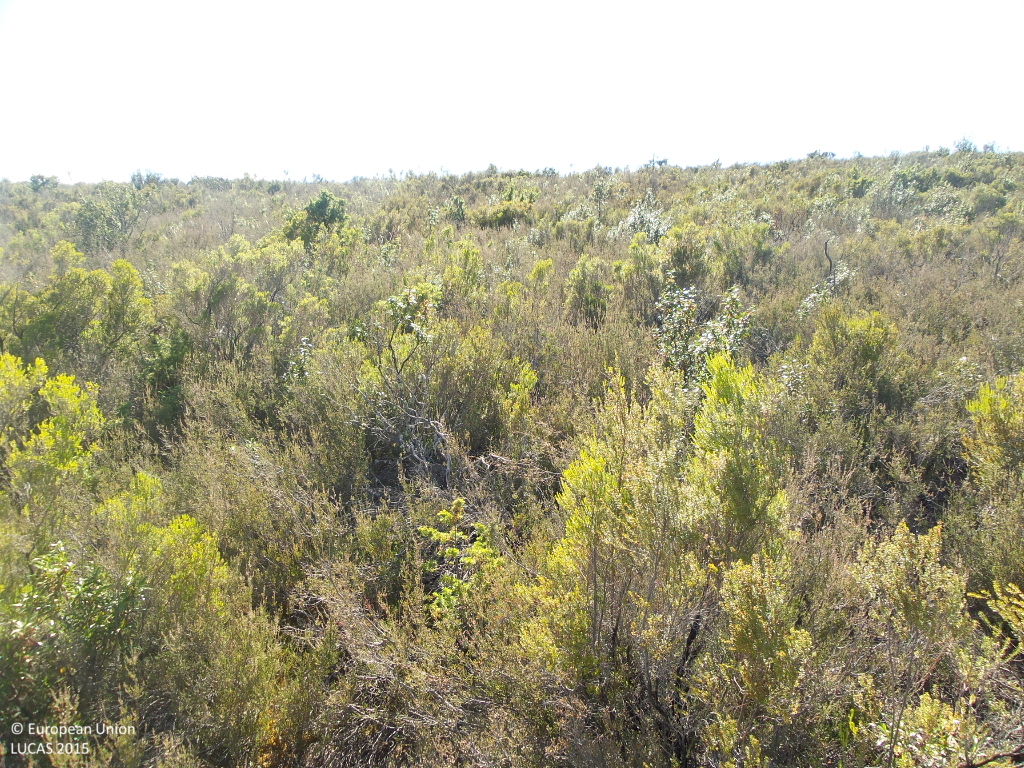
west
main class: Shrubland
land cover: Shrubland without tree cover
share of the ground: > 75 %
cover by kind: shrubs 100 %
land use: Semi-natural and natural areas not in use
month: June
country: ES
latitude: 41.1138
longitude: -3.0302
